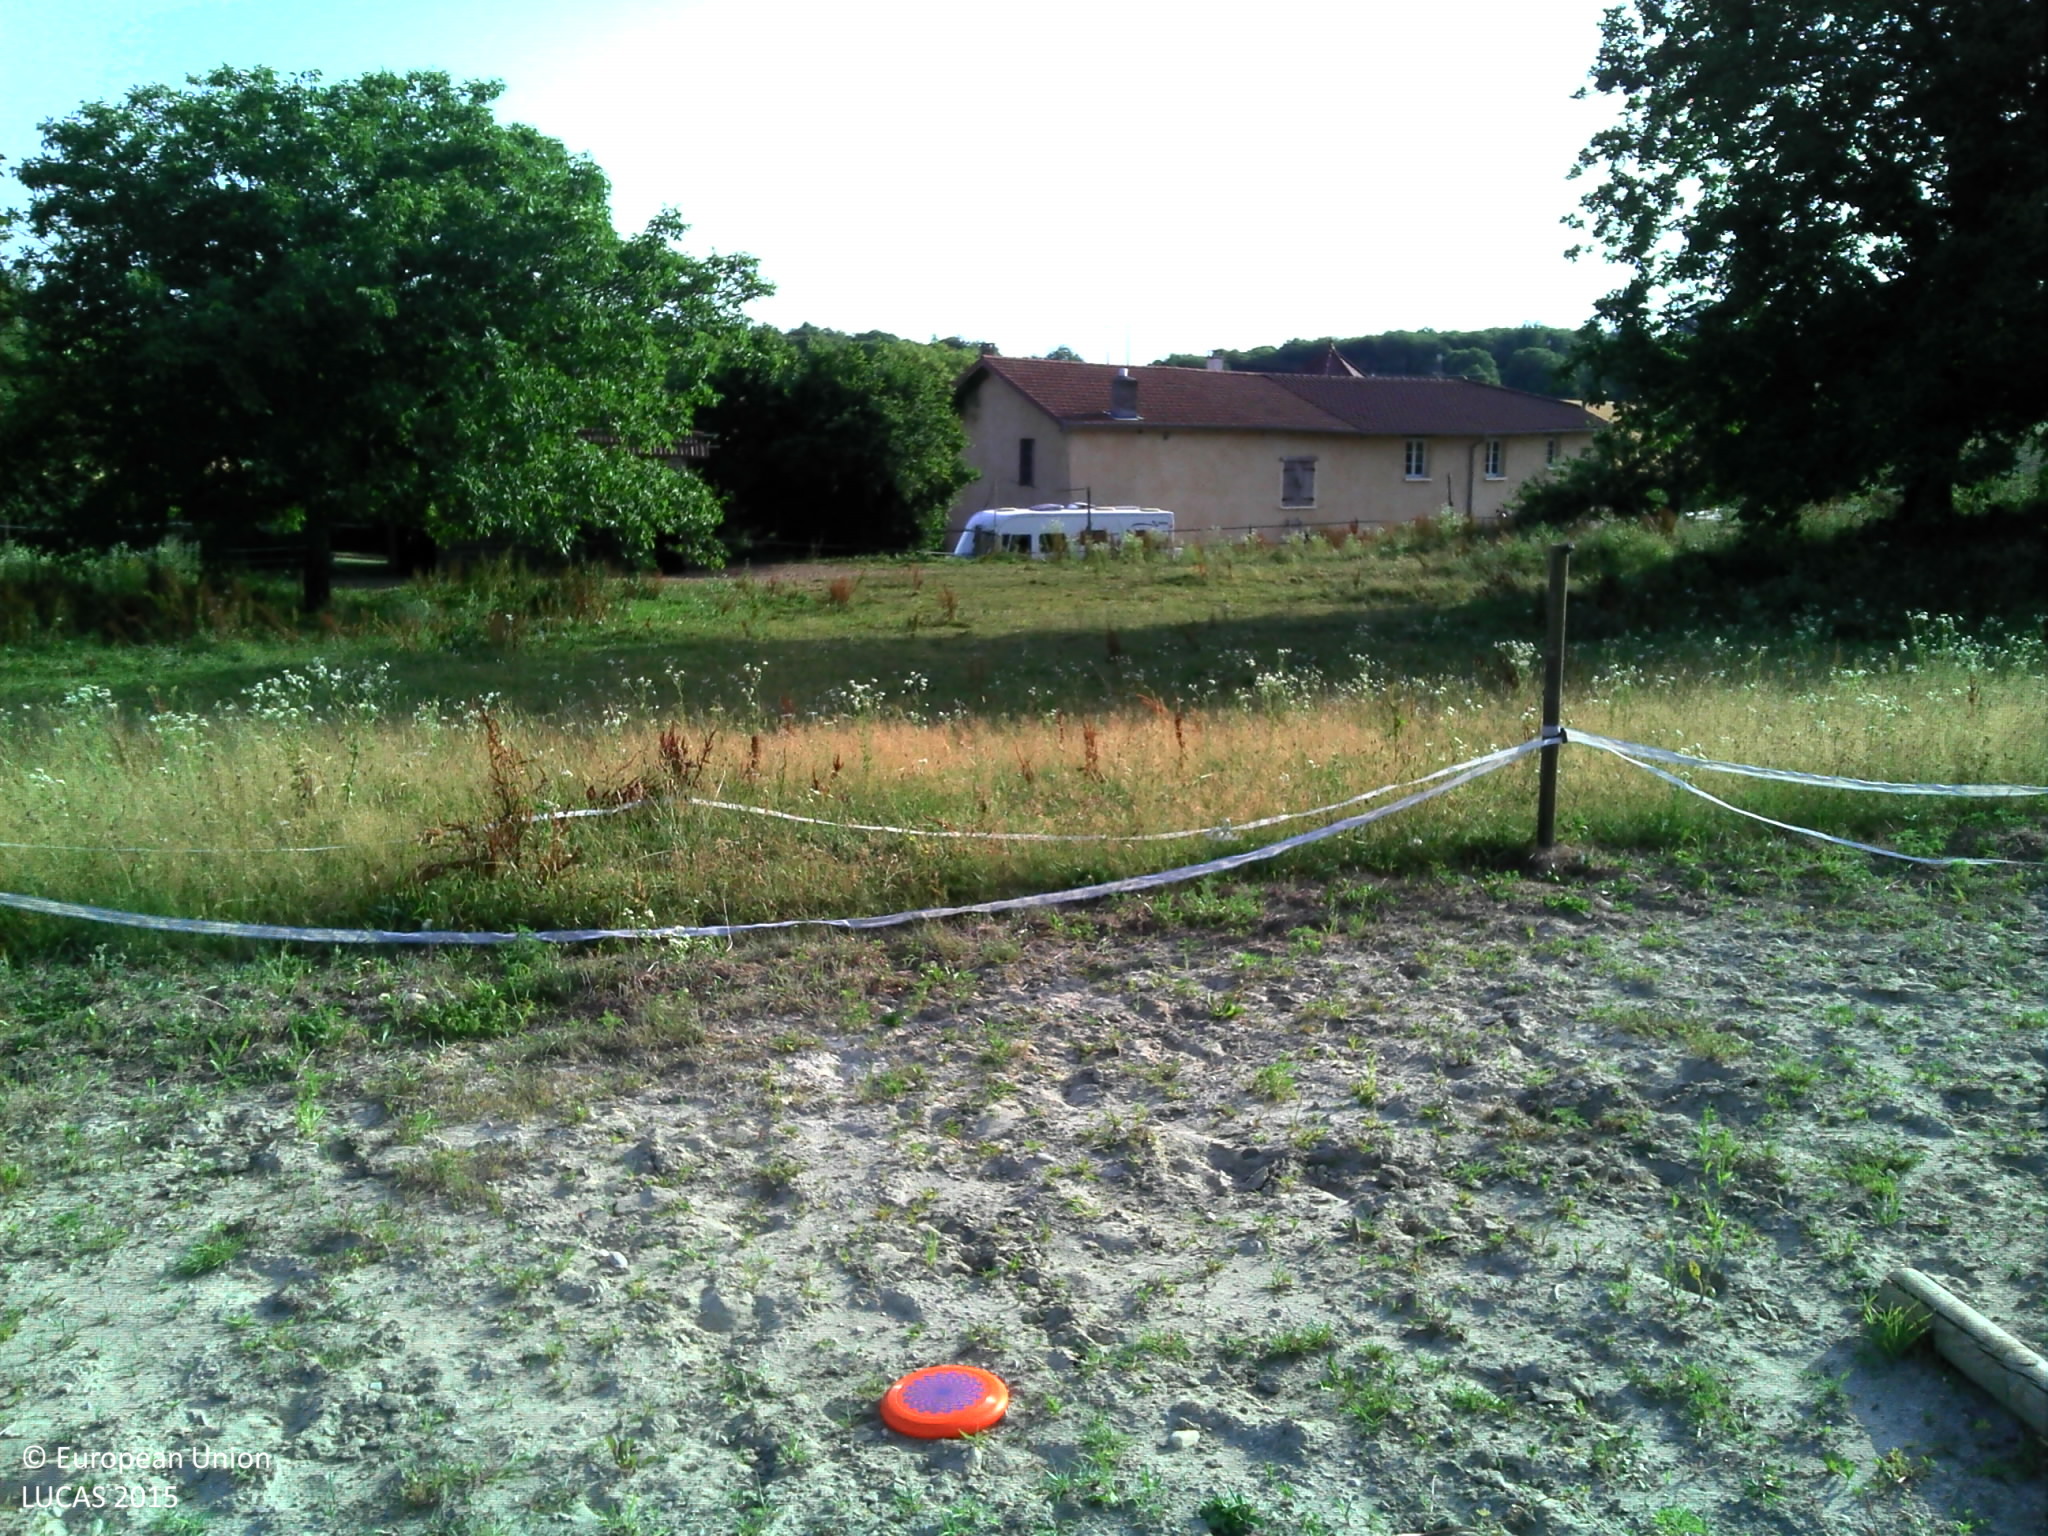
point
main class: Grassland
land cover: Grassland without tree/shrub cover
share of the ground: > 75 %
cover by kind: unconsolidated bare surface 85 %, herbaceous plants 15 %
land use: Agriculture (excluding fallow land and kitchen gardens)
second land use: Sport
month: July
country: FR
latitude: 45.5577
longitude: 5.2003
